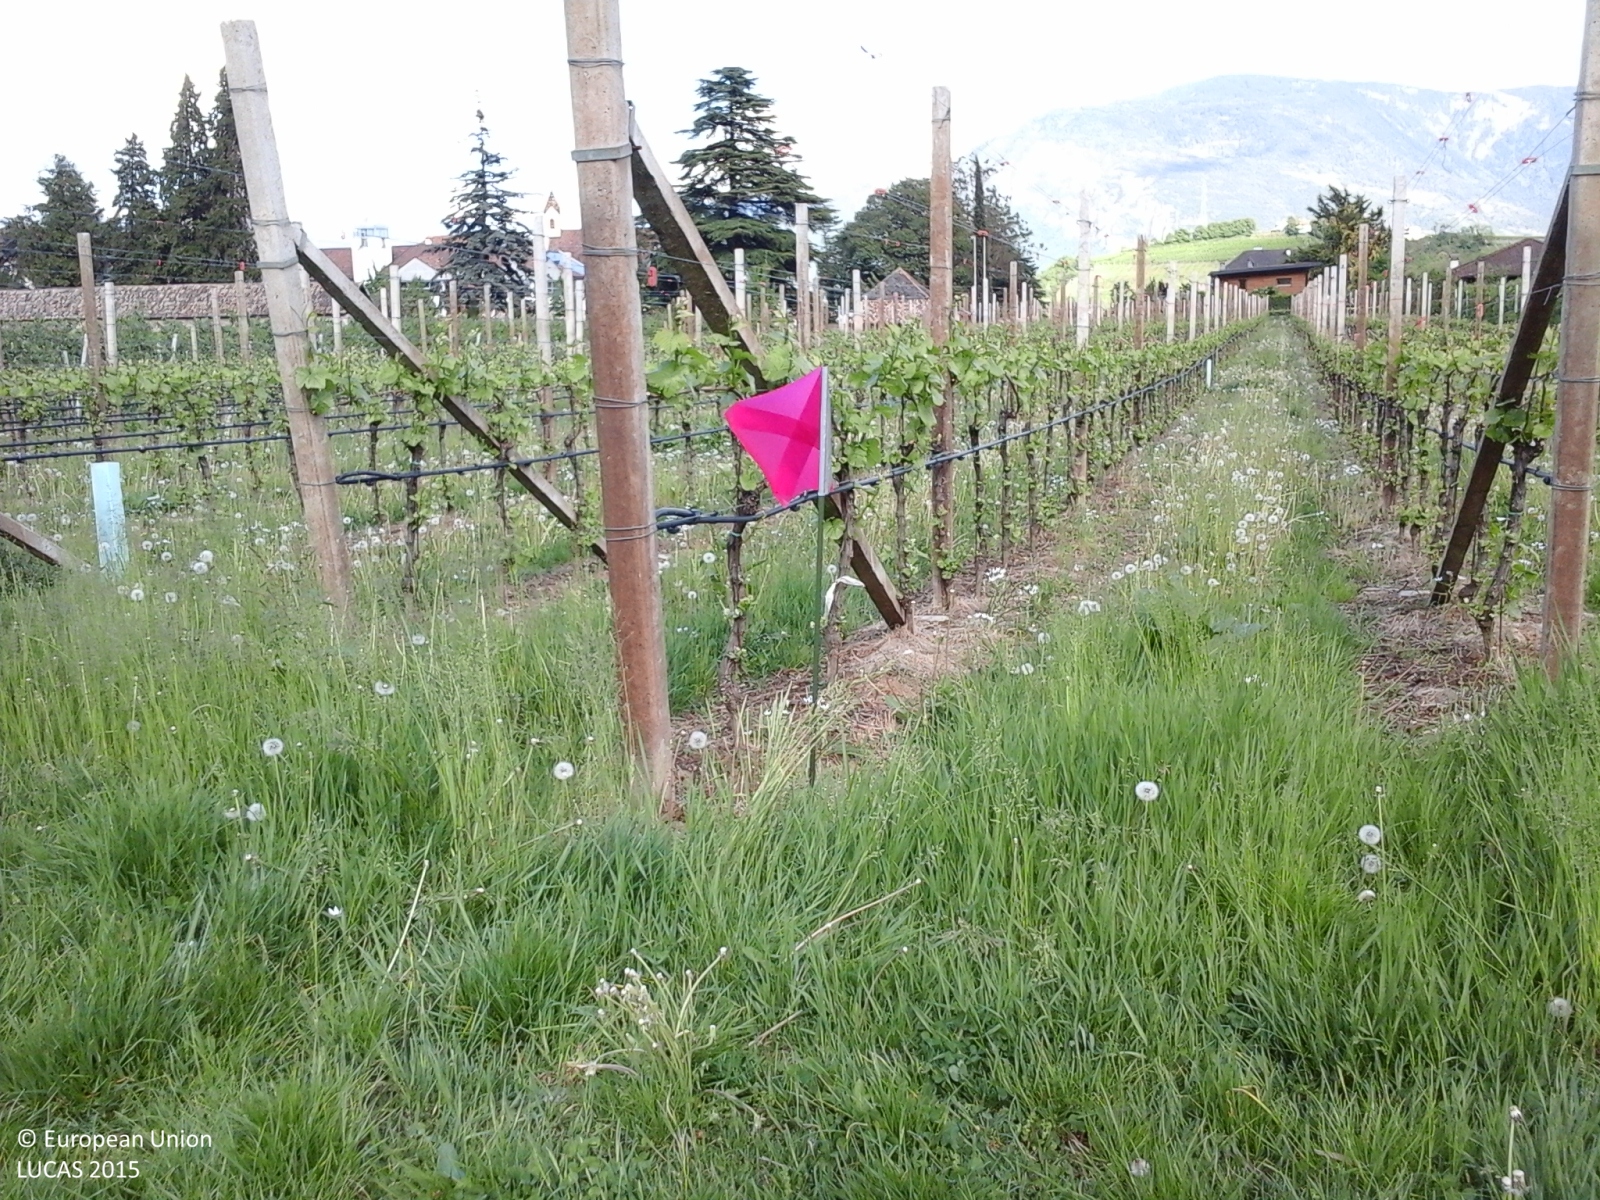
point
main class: Cropland
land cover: Vineyards
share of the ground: 50 - 75 %
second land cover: Grassland without tree/shrub cover
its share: 50 - 75 %
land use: Agriculture (excluding fallow land and kitchen gardens)
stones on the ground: < 10 %
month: April
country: IT
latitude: 46.4699
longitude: 11.2617
